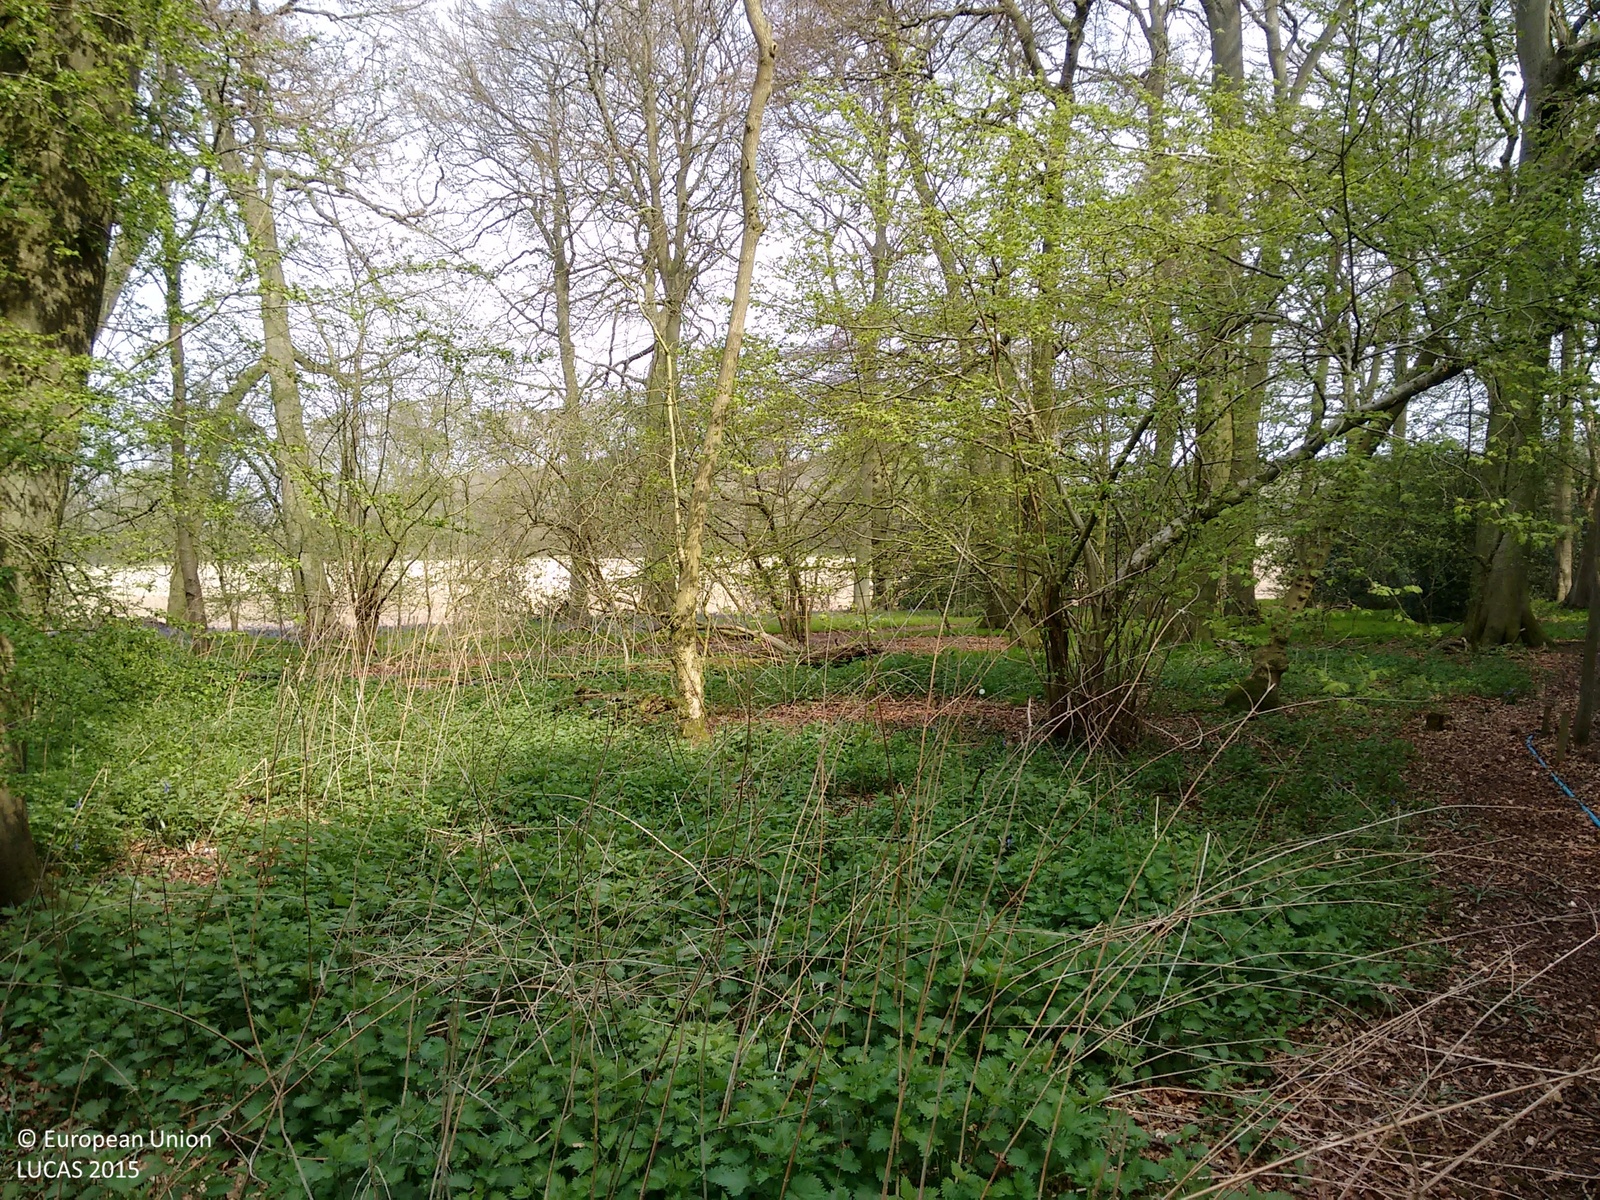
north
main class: Woodland
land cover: Broadleaved woodland
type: mesophytic deciduous forest
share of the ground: > 75 %
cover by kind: broadleaved forest trees 100 %
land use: Forestry
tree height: > 5 m
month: April
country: GB
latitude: 51.7228
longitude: -0.7686
